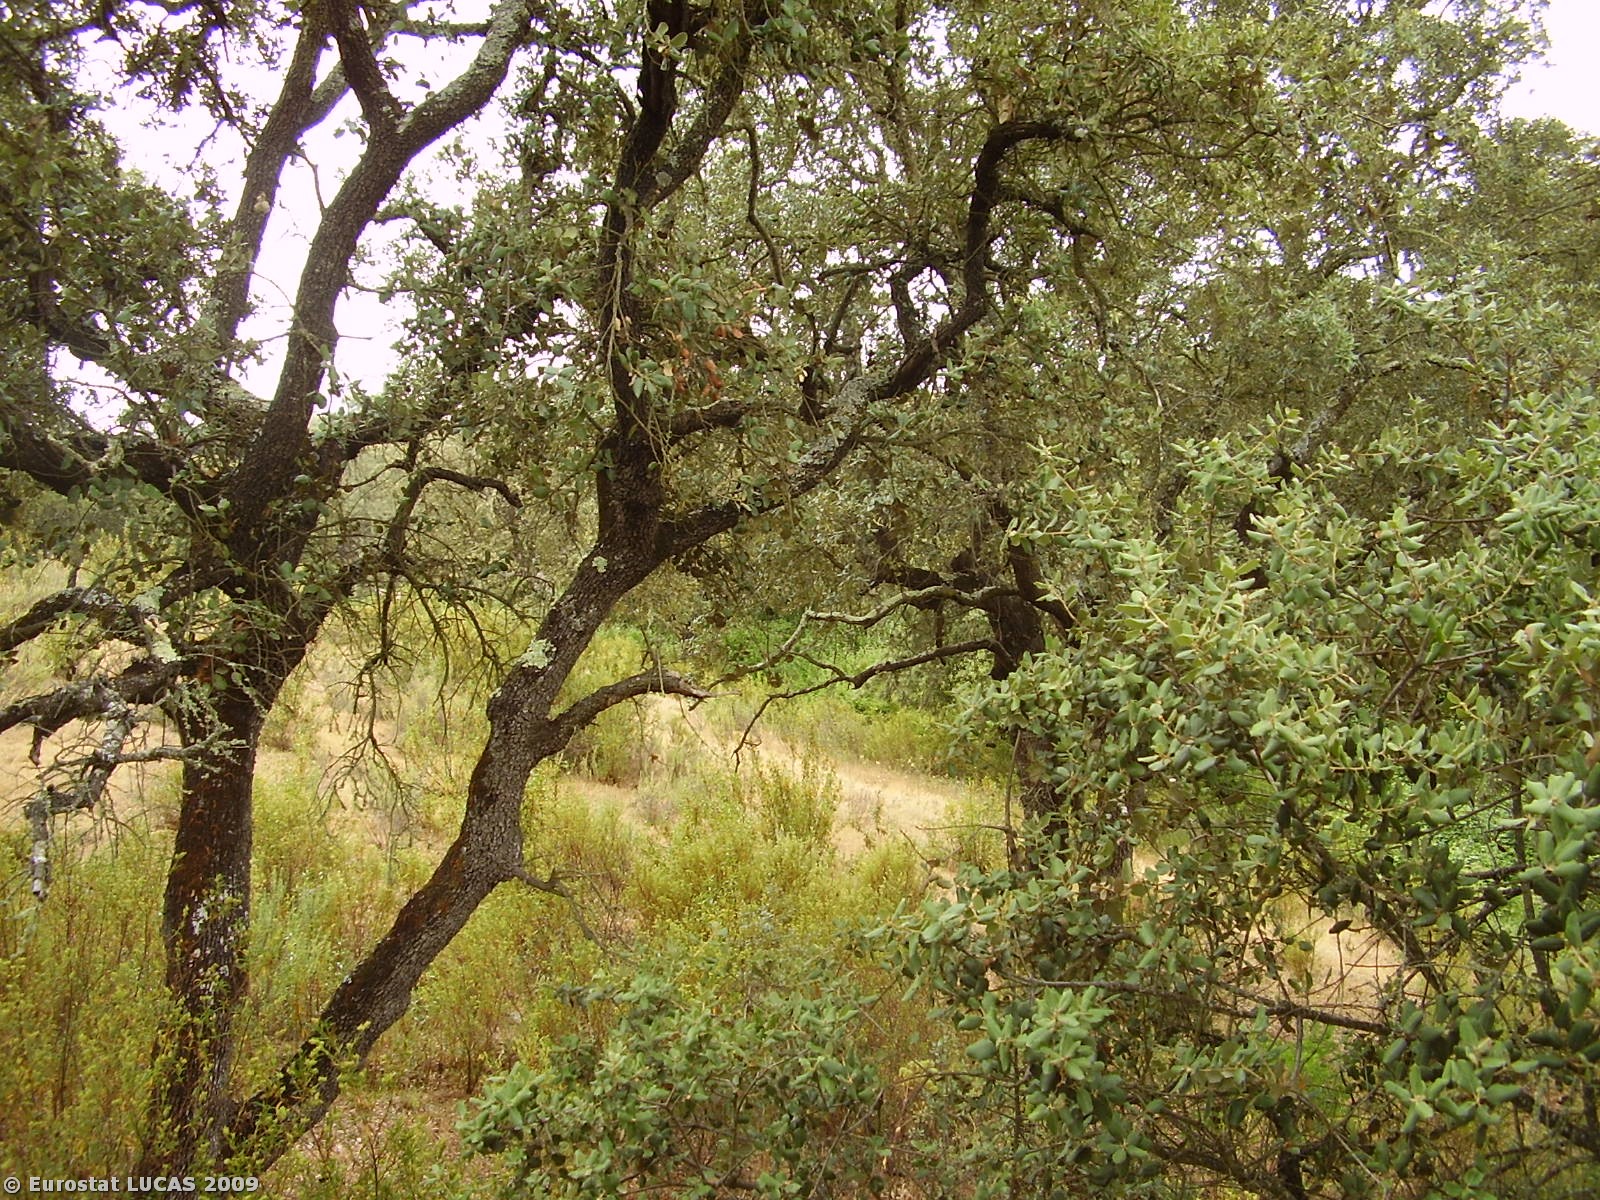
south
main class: Shrubland
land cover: Shrubland with sparse tree cover
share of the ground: 50 - 75 %
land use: Fallow land
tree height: > 5 m
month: May
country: PT
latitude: 37.8242
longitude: -7.7325
